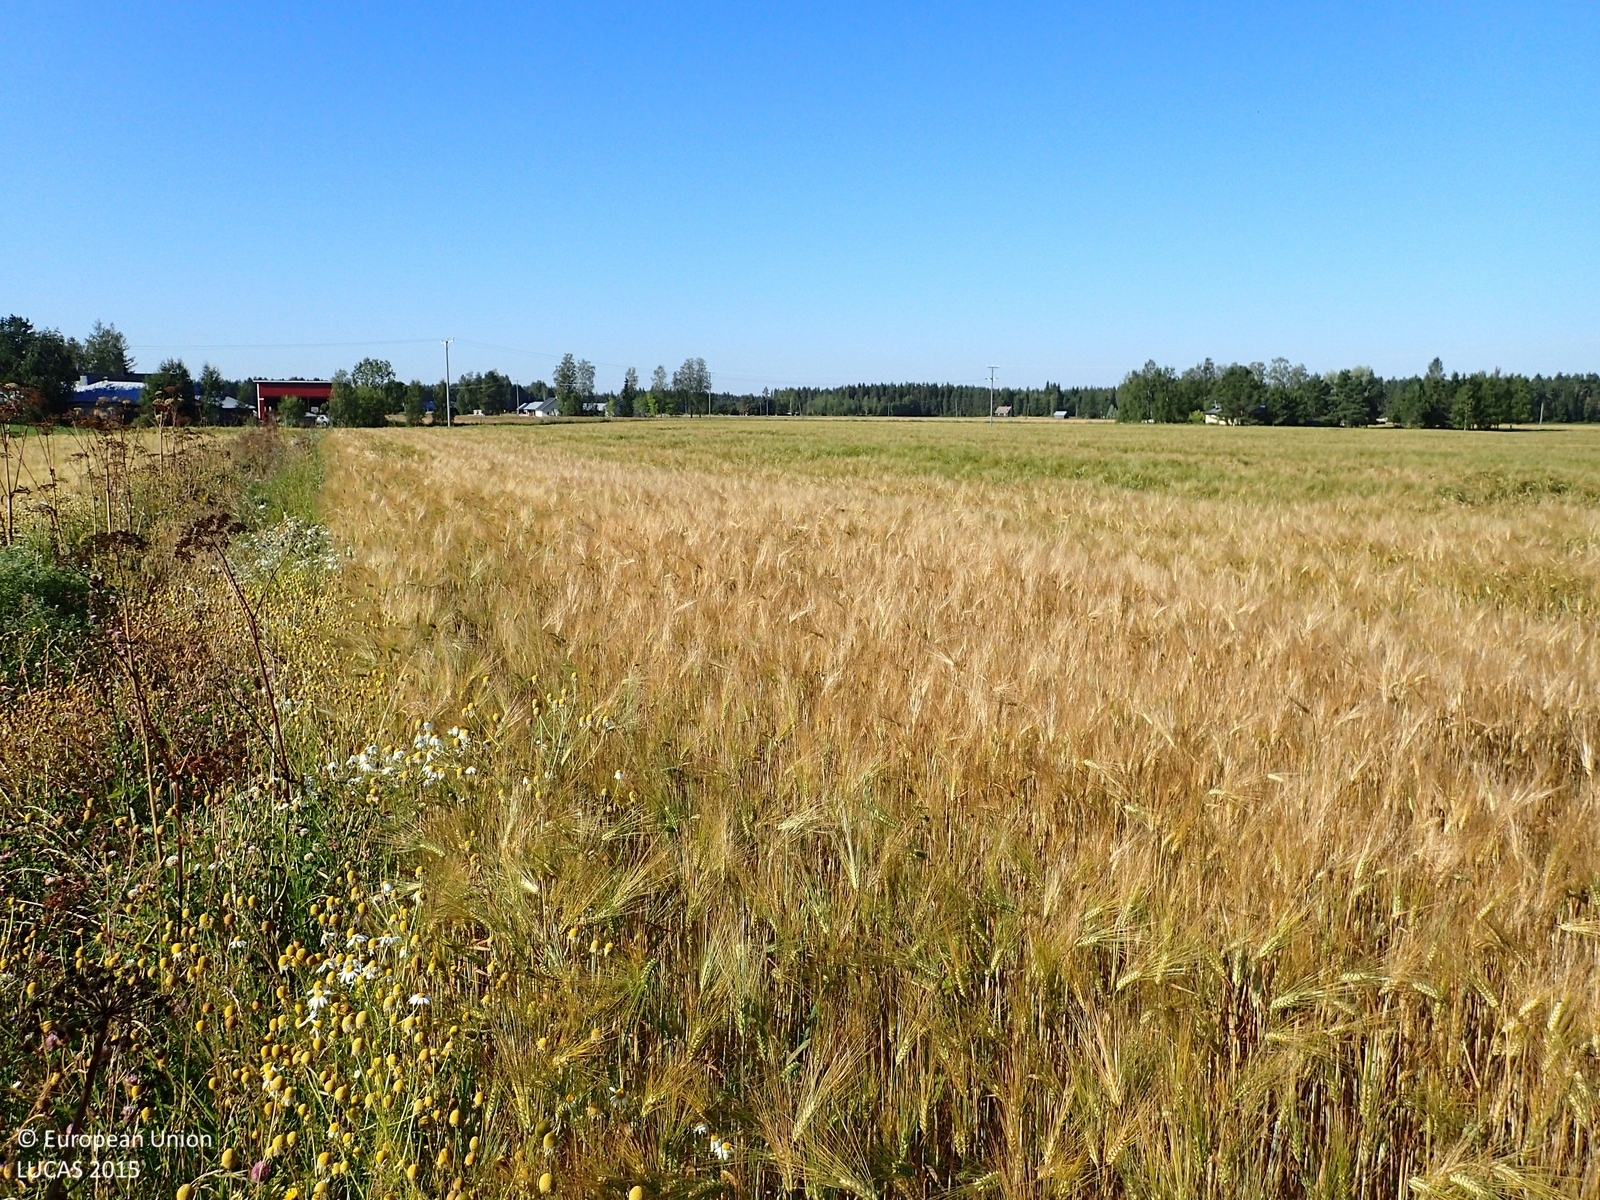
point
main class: Cropland
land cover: Barley
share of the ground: > 75 %
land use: Agriculture (excluding fallow land and kitchen gardens)
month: August
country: FI
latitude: 62.4916
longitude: 21.8273
